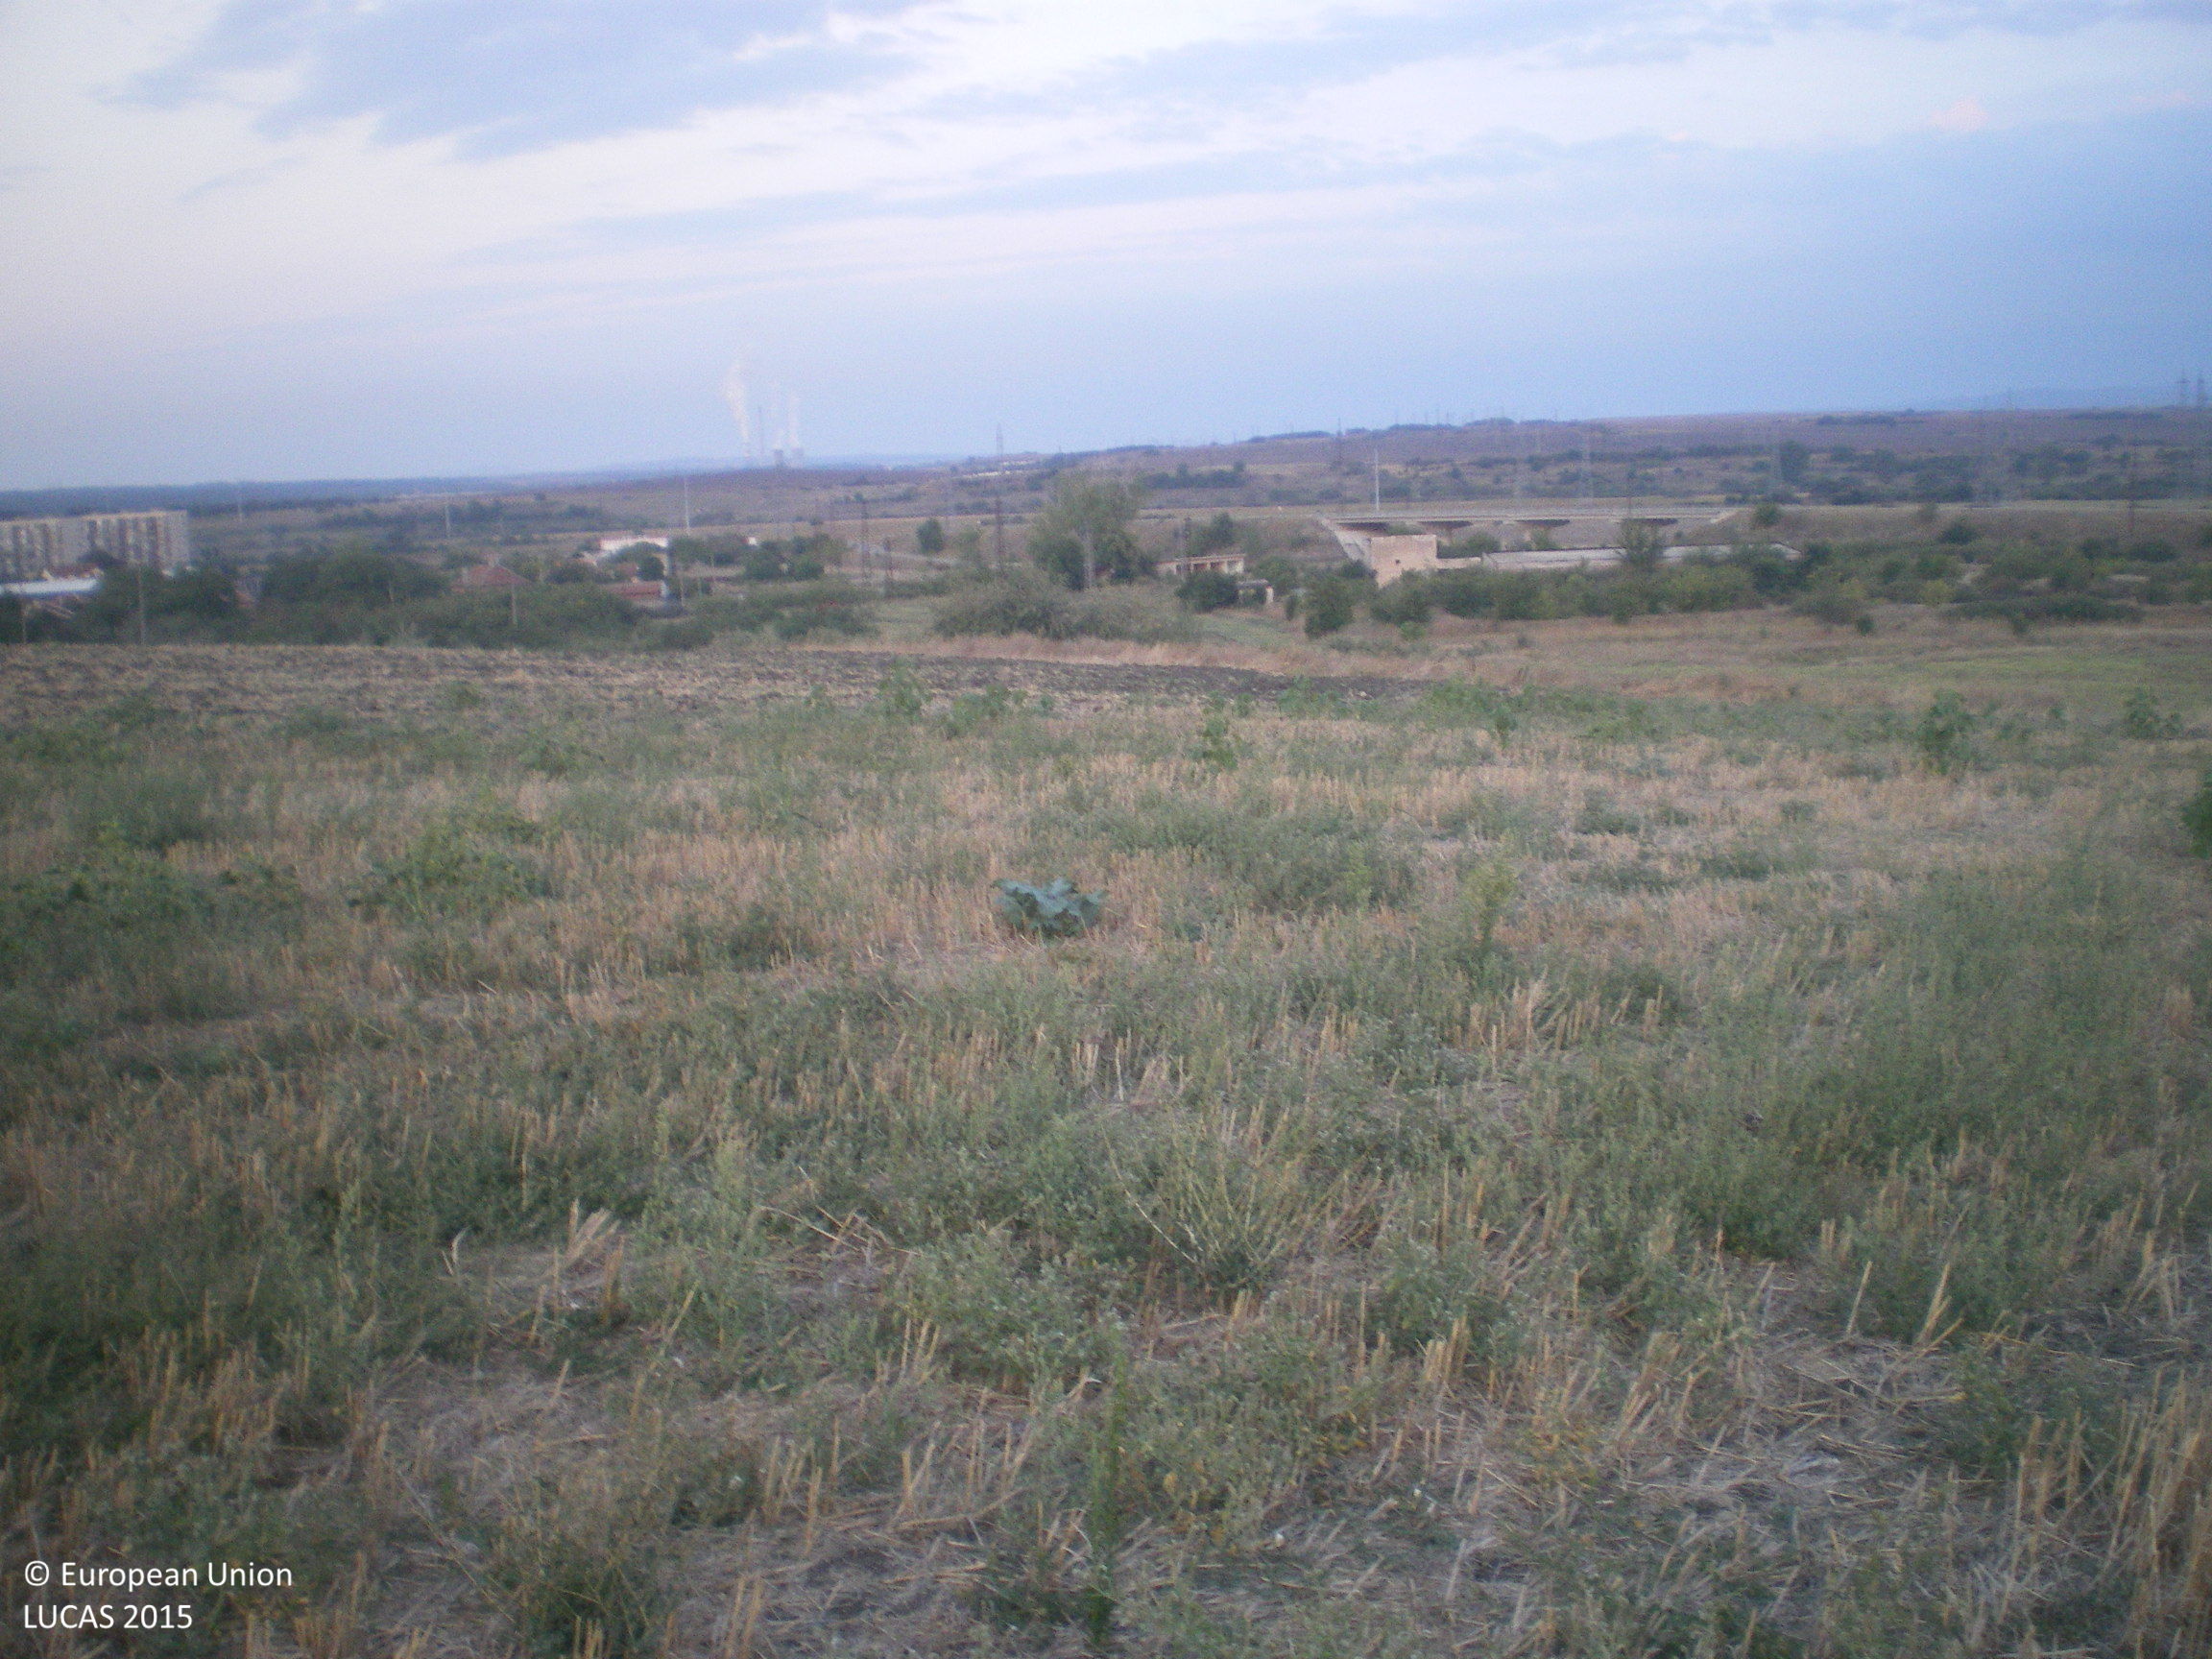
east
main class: Cropland
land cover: Common wheat
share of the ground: < 10 %
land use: Agriculture (excluding fallow land and kitchen gardens)
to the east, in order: Common wheat; Tracks; Sunflower; Grassland with sparse tree/shrub cover; Sunflower; Grassland without tree/shrub cover; Grassland with sparse tree/shrub cover; Ditches and canals; Grassland without tree/shrub cover
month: September
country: BG
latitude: 42.1299
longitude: 25.8603
